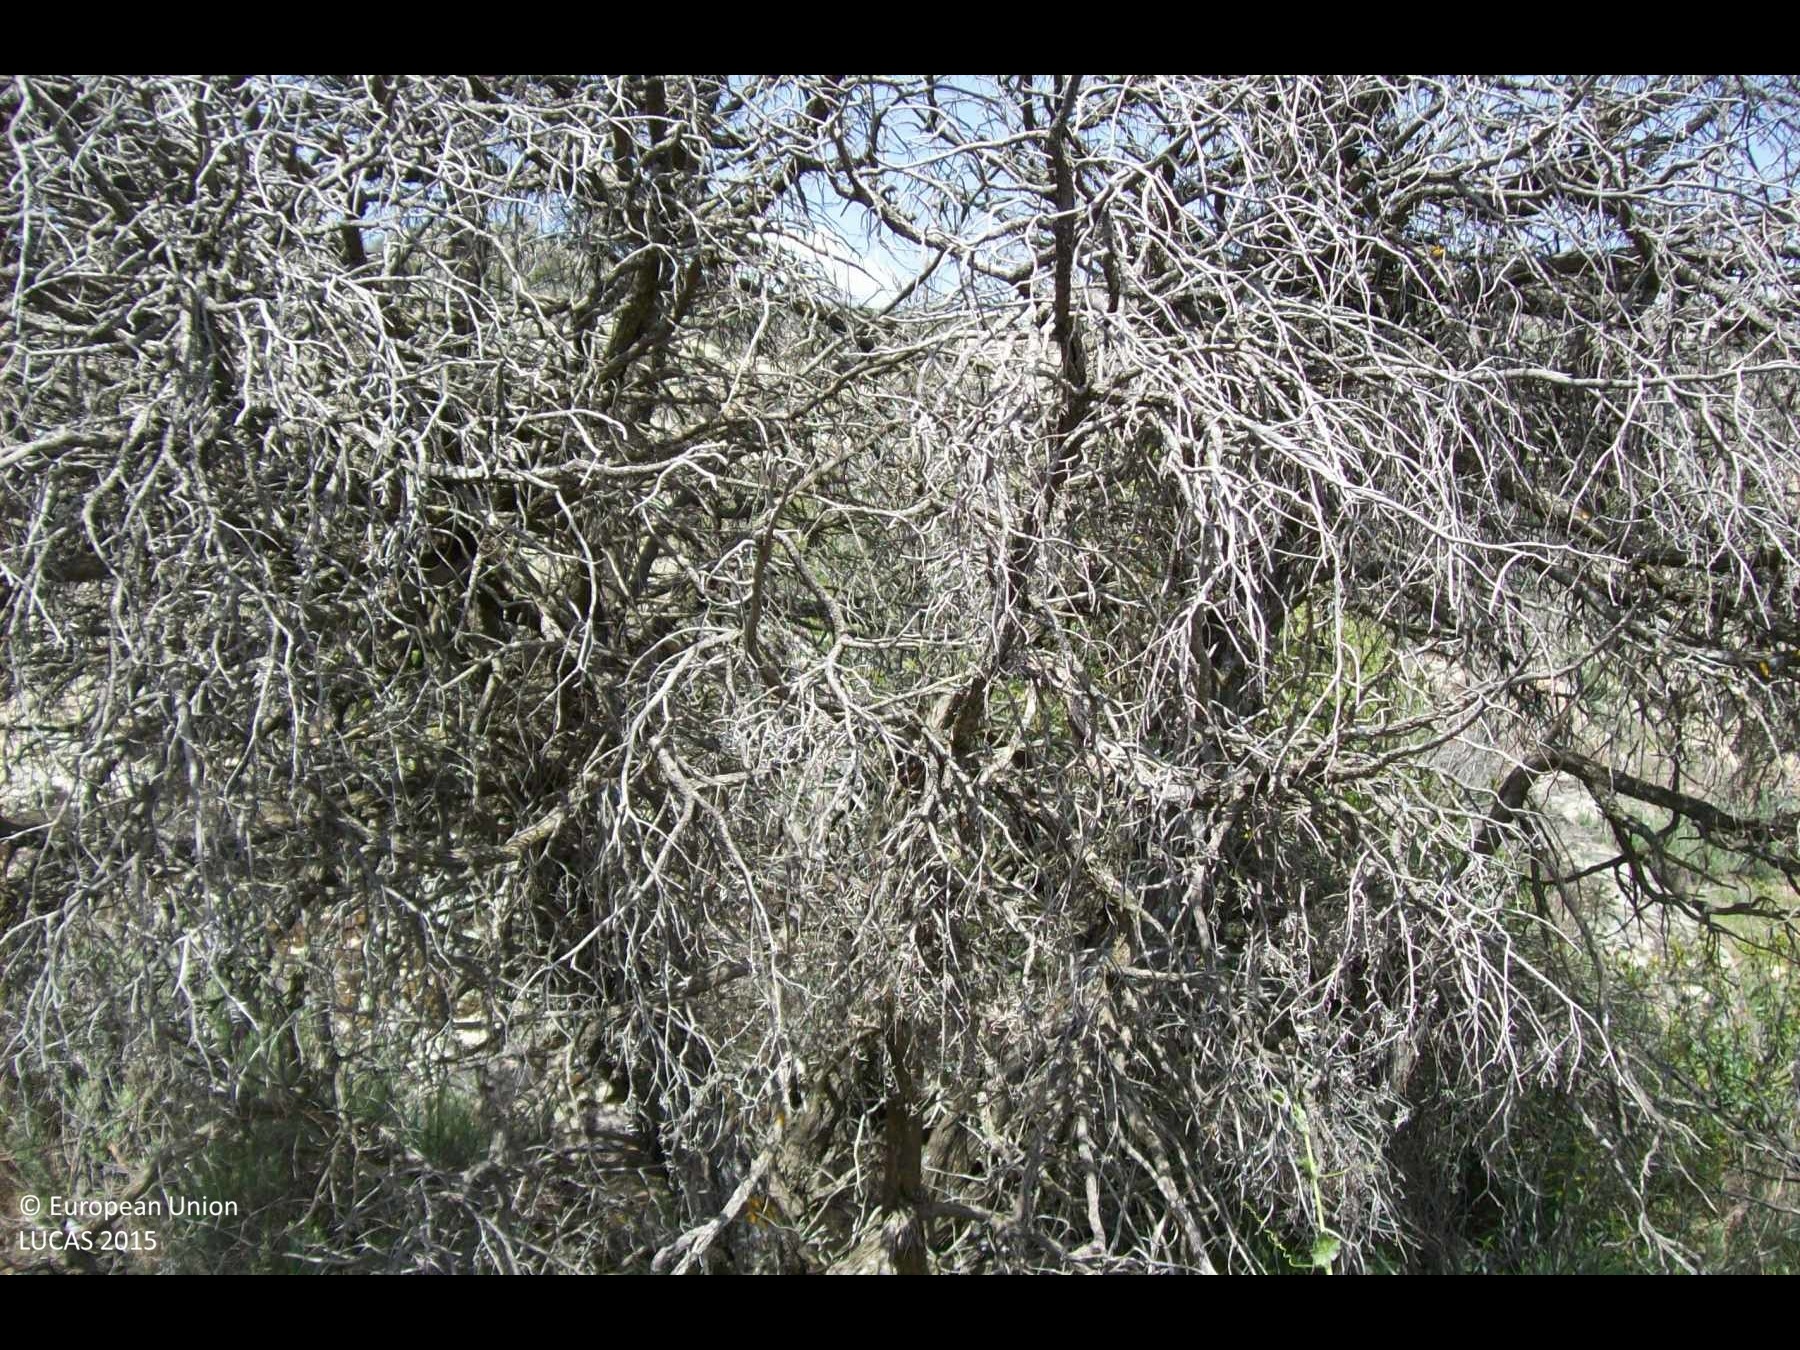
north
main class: Shrubland
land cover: Shrubland with sparse tree cover
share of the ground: > 75 %
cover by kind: consolidated bare surface 40 %, shrubs 35 %, herbaceous plants 20 %, coniferous forest trees 5 %
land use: Semi-natural and natural areas not in use
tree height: < 5 m
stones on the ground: < 10 %
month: April
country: ES
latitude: 40.6381
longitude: -3.9609
